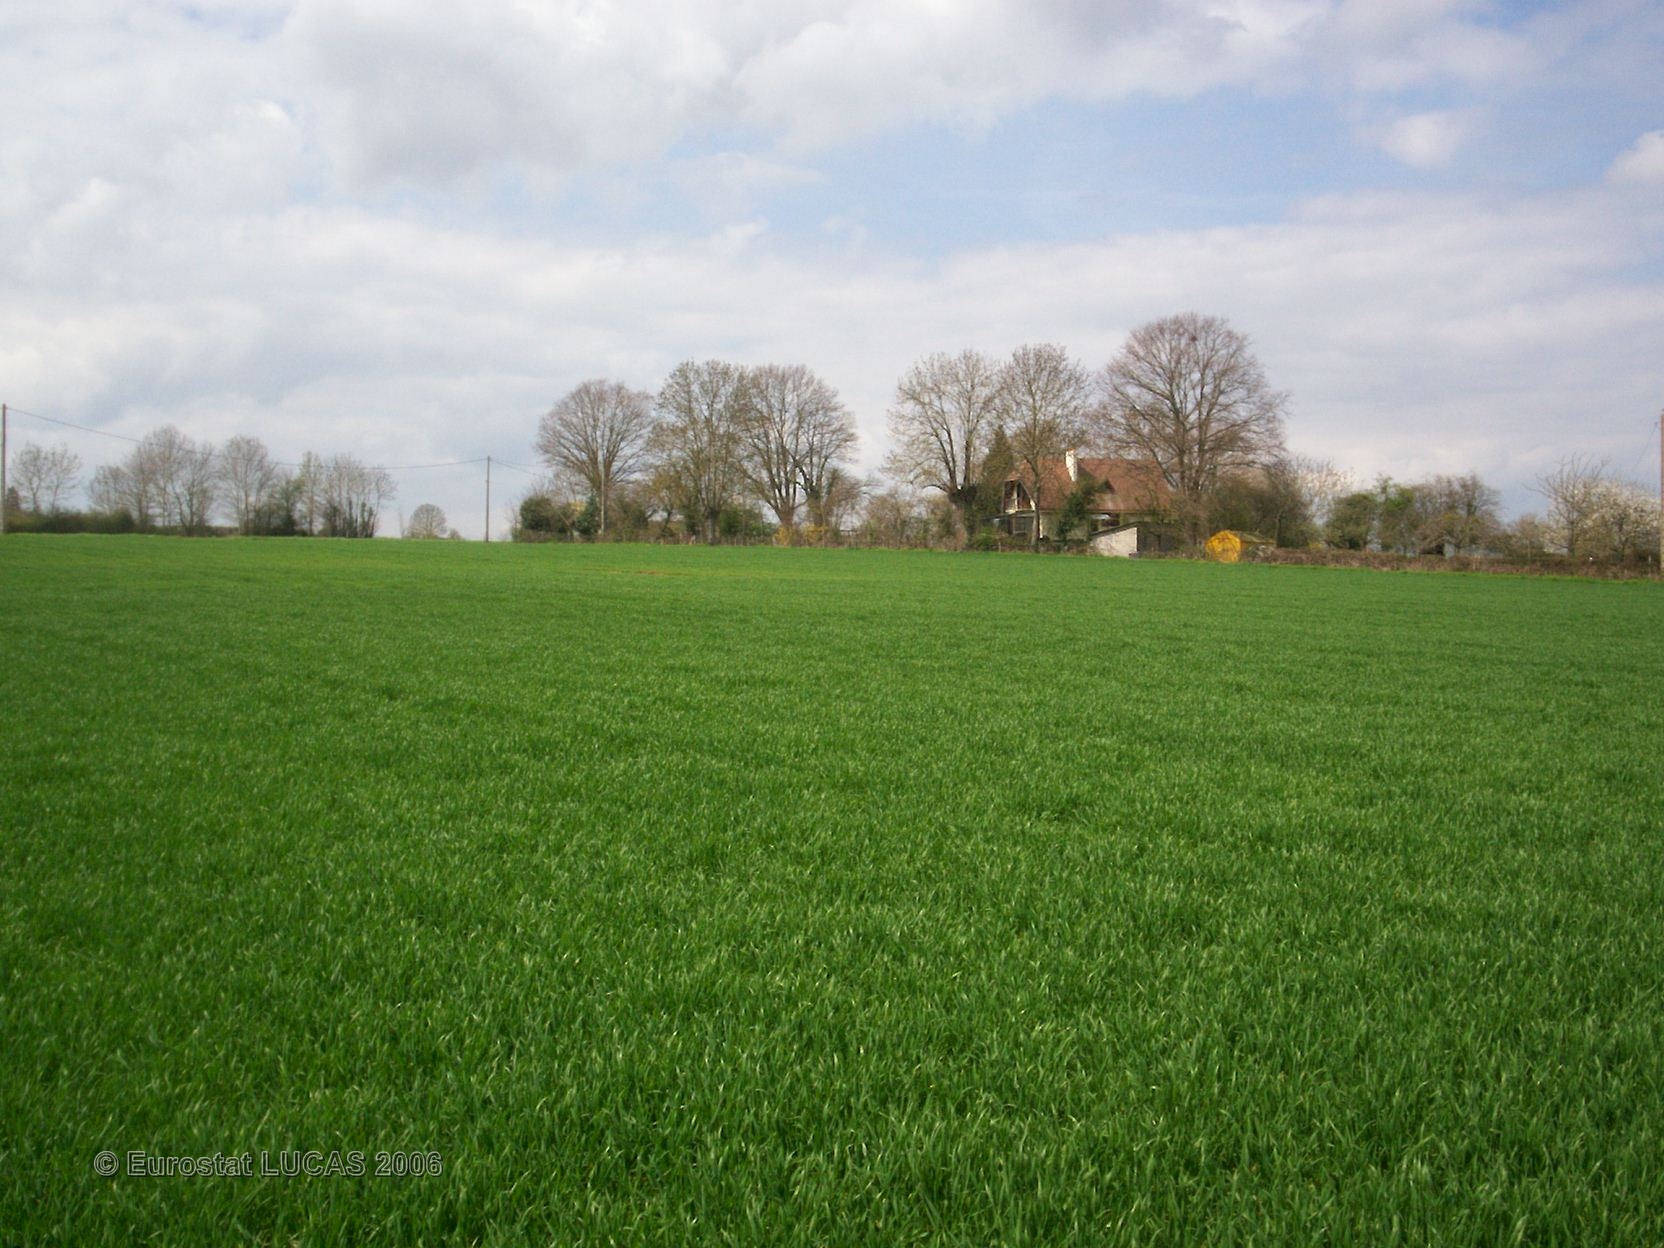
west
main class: Cropland
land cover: Common wheat
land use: Agriculture (excluding fallow land and kitchen gardens)
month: April
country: FR
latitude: 49.0187
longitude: 0.0009
